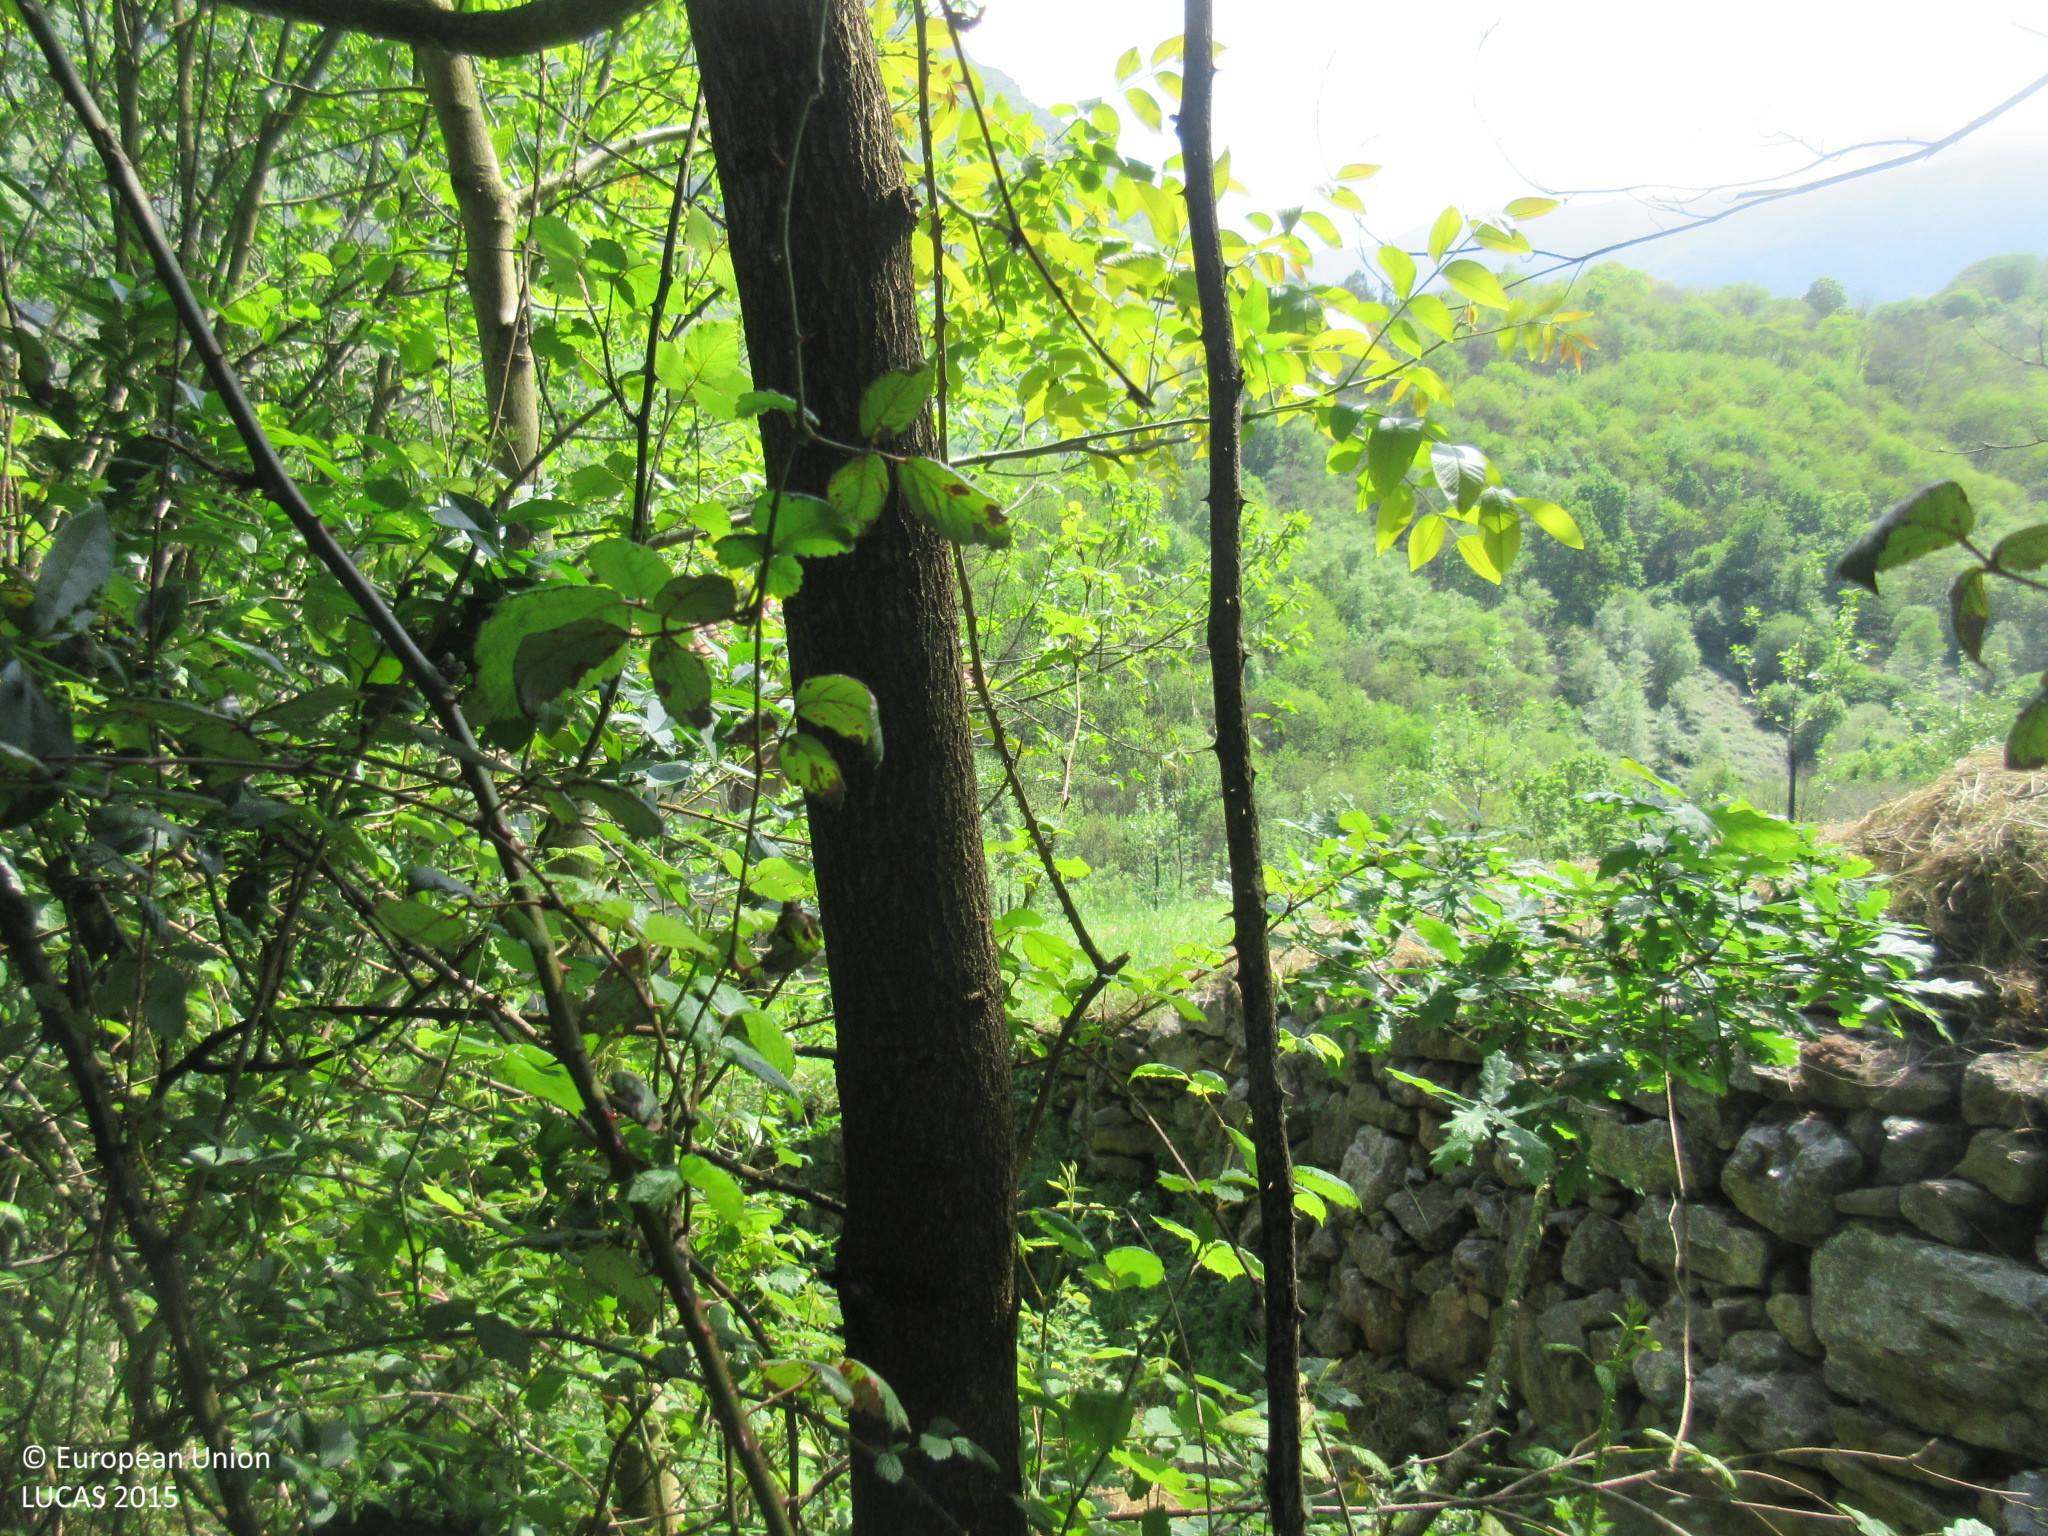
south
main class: Shrubland
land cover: Shrubland with sparse tree cover
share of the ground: > 75 %
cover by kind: shrubs 95 %, broadleaved forest trees 5 %
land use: Semi-natural and natural areas not in use
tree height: > 5 m
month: May
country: ES
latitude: 43.2807
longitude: -5.8982
